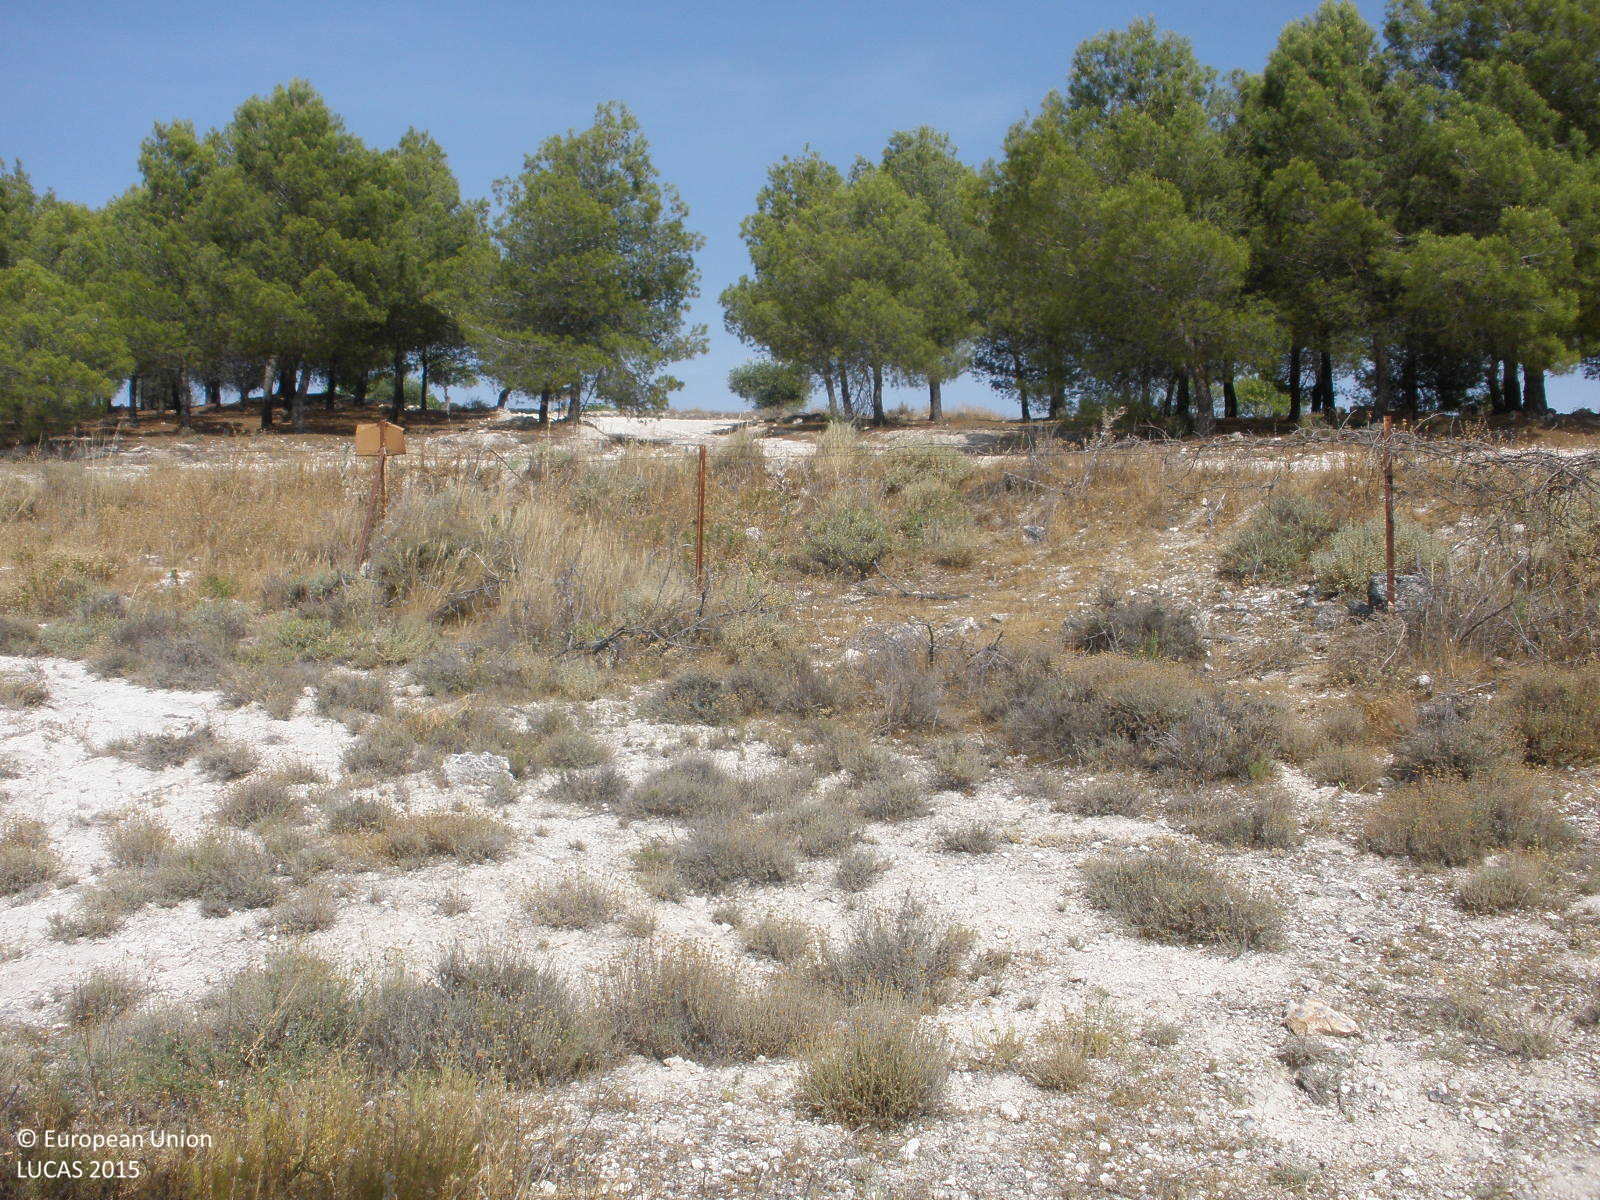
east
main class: Cropland
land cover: Olive groves
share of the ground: 25 - 50 %
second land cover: Grassland without tree/shrub cover
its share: 10 - 25 %
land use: Agriculture (excluding fallow land and kitchen gardens)
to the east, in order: Olive groves; Grassland without tree/shrub cover; Fences; Shrubland without tree cover; Tracks; Pine dominated coniferous woodland; Tracks; Shruby margins; Olive groves; Shrubland with sparse tree cover; Olive groves; Shrubland without tree cover; Tracks
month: July
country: ES
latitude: 40.3479
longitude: -3.4191
